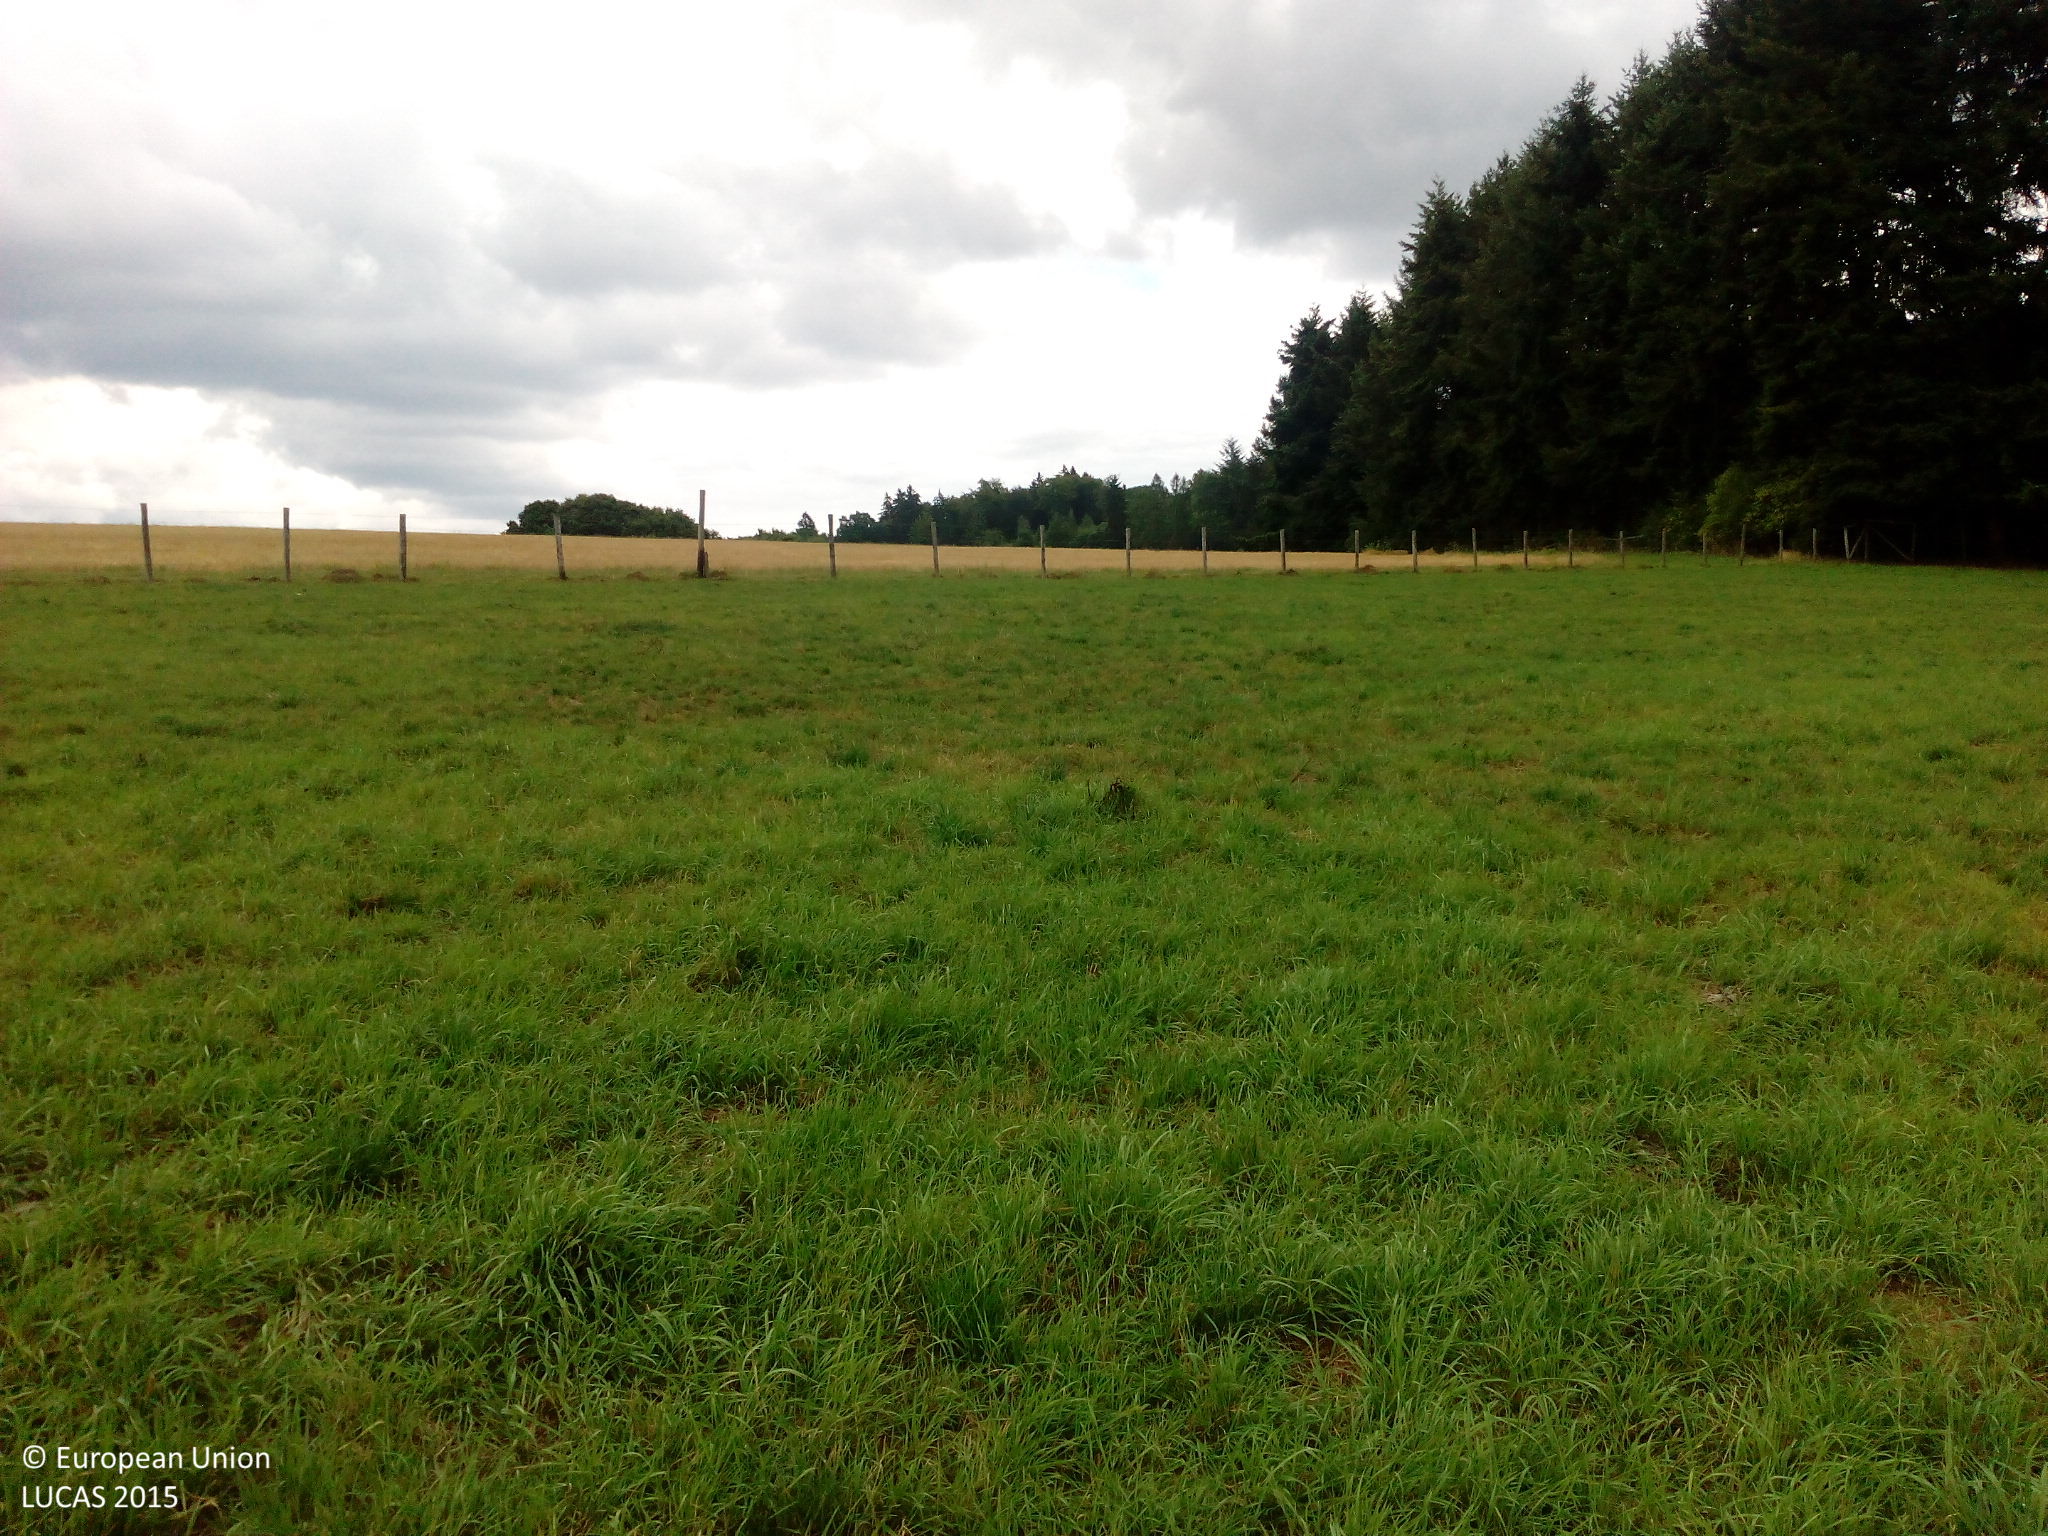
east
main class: Grassland
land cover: Grassland without tree/shrub cover
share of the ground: > 75 %
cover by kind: herbaceous plants 95 %, unconsolidated bare surface 5 %
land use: Agriculture (excluding fallow land and kitchen gardens)
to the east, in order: Grassland without tree/shrub cover; Fences; Tracks; Grassland without tree/shrub cover; Barley; Grassland without tree/shrub cover; Oats; Grassland without tree/shrub cover; Shruby margins; Fences; Grassland without tree/shrub cover
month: August
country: DE
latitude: 50.0489
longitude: 7.5005
